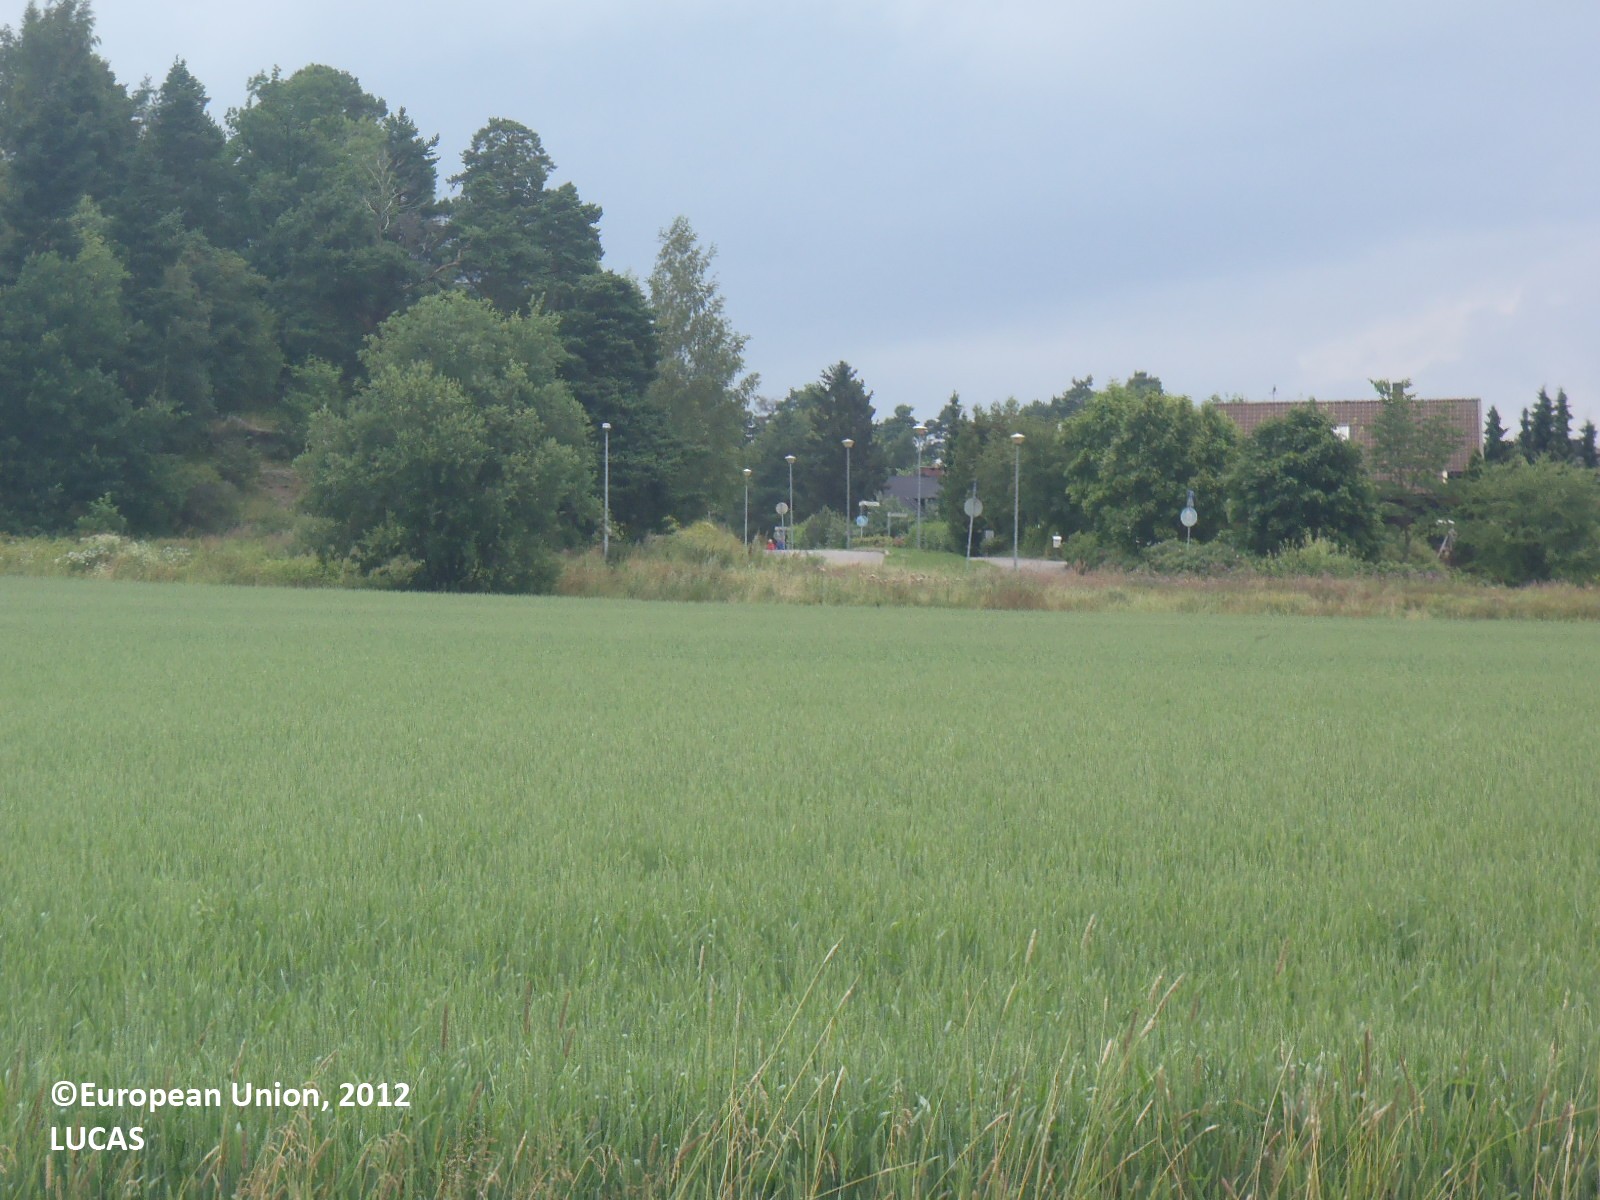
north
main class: Cropland
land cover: Common wheat
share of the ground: > 75 %
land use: Agriculture (excluding fallow land and kitchen gardens)
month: July
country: FI
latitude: 60.4109
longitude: 22.2496
